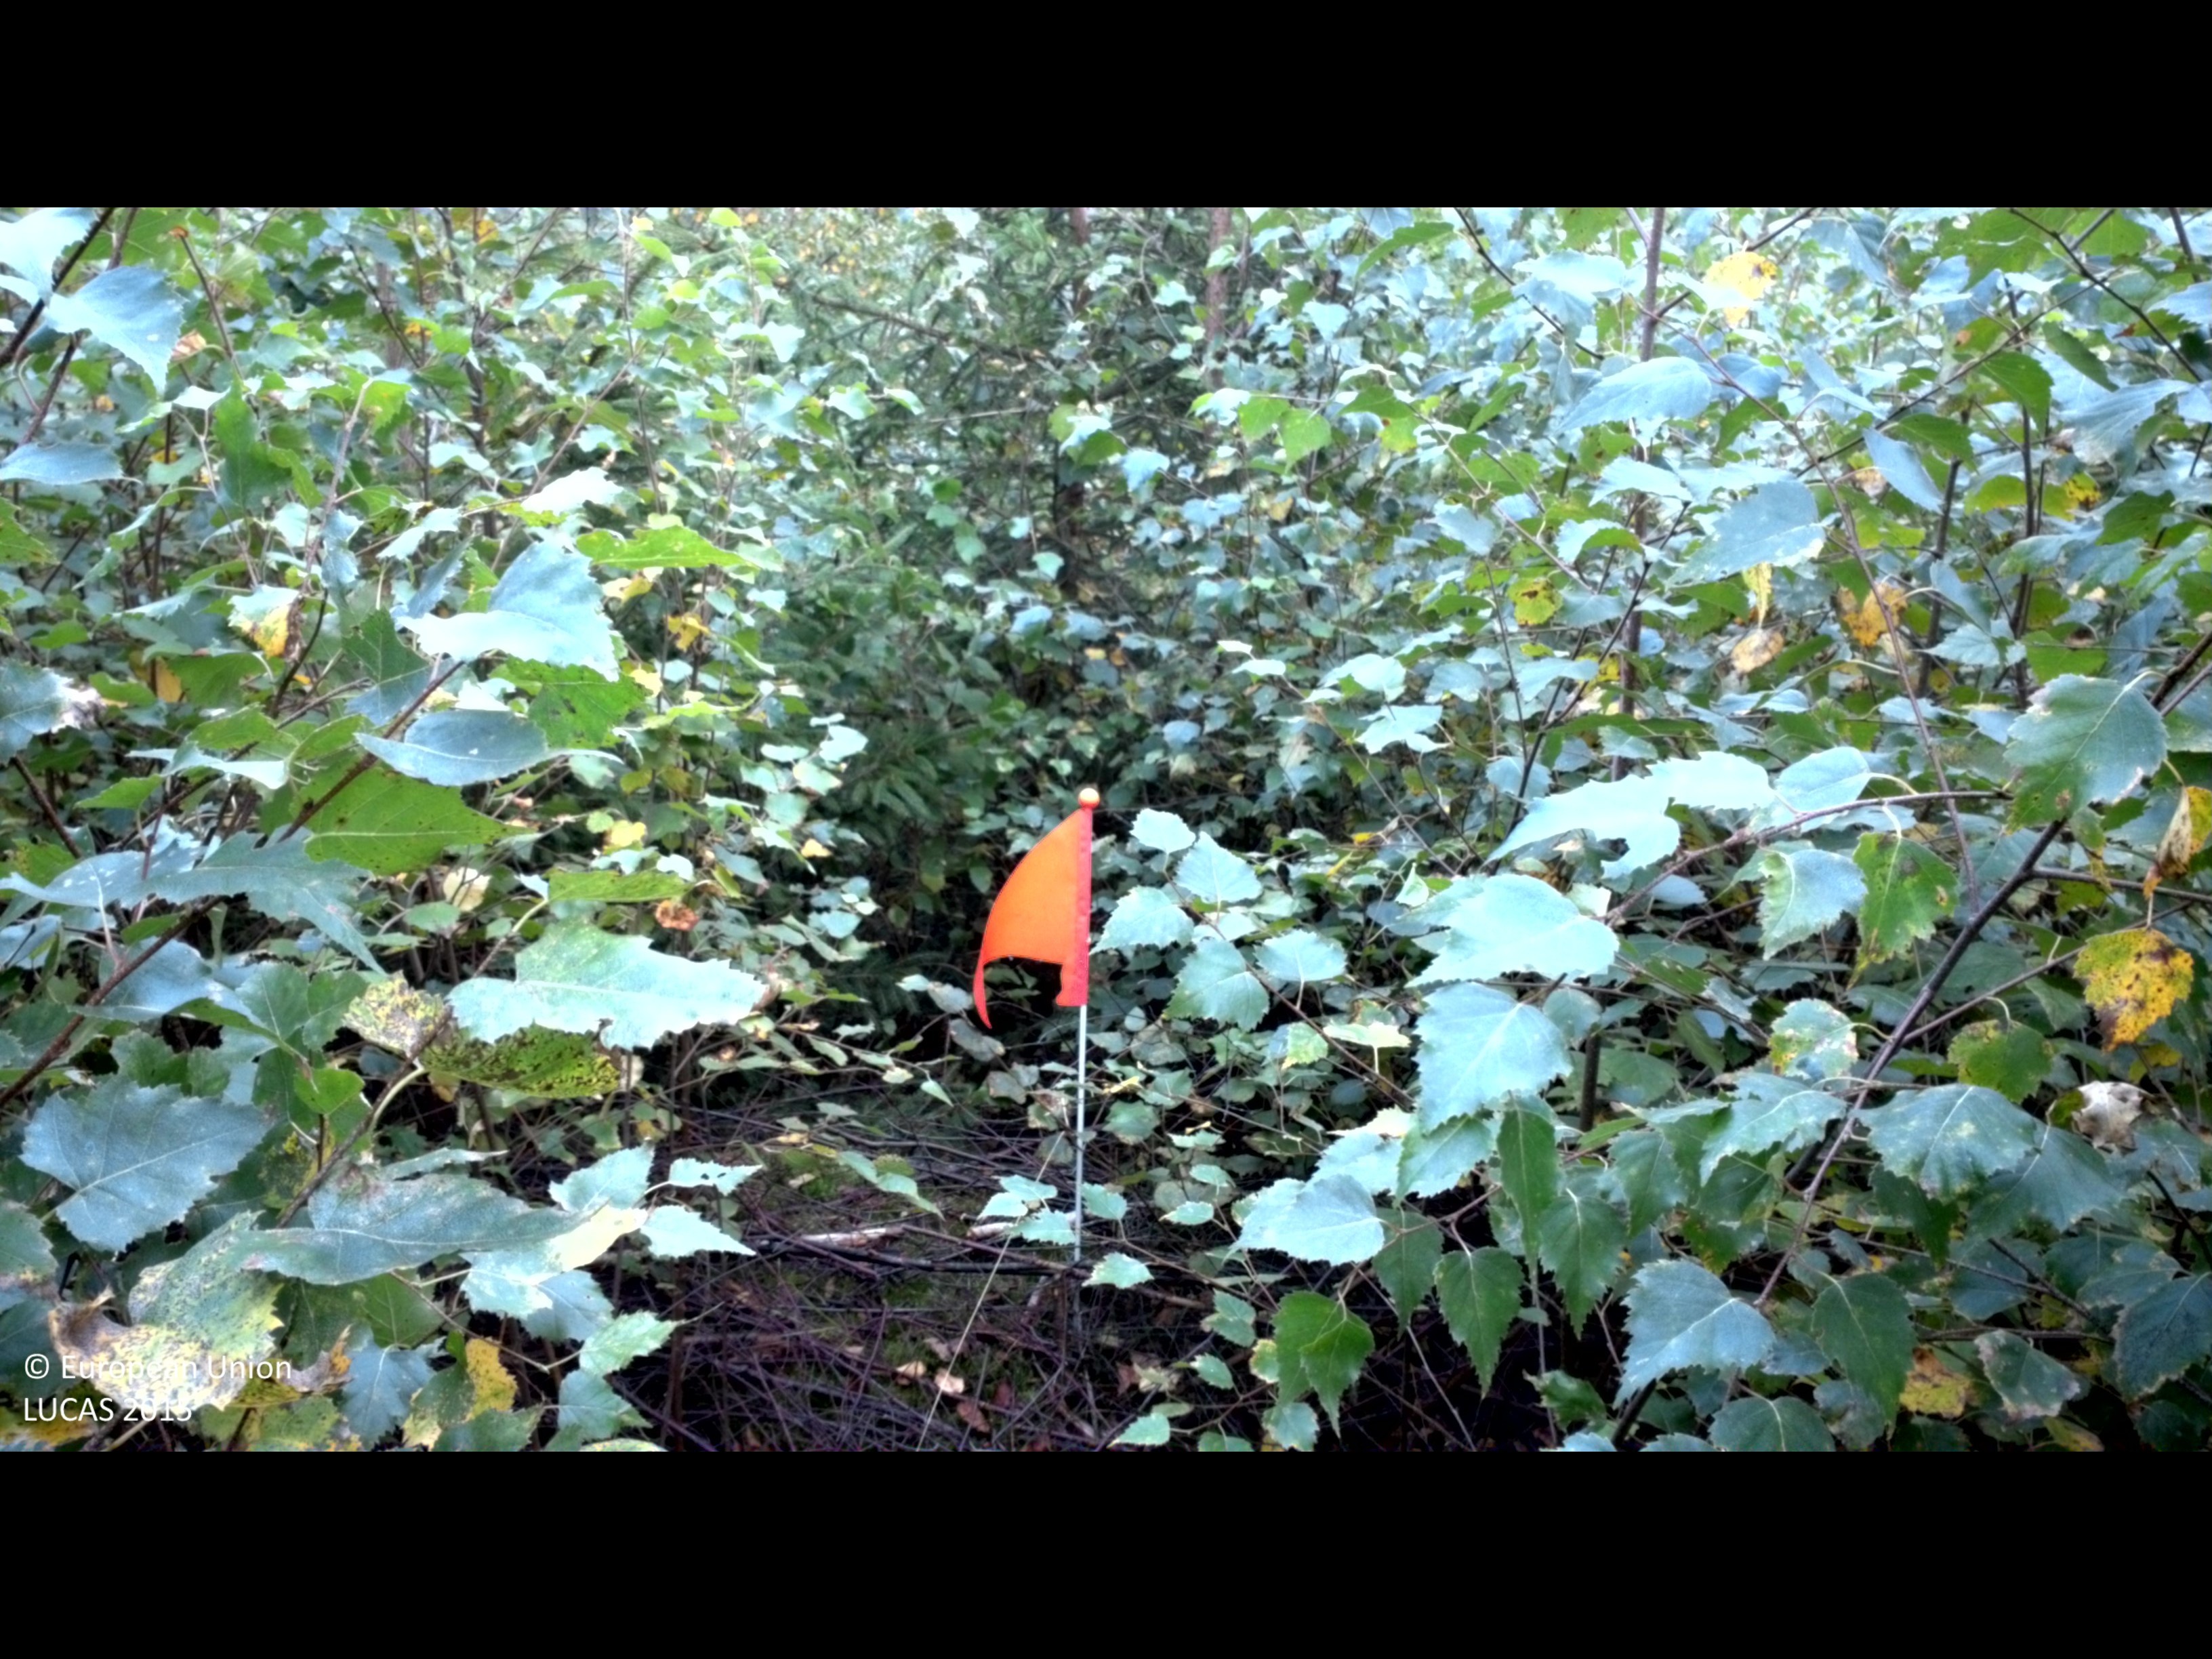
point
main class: Woodland
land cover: Spruce dominated mixed woodland
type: boreal forest
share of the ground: > 75 %
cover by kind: broadleaved forest trees 55 %, coniferous forest trees 35 %, shrubs 5 %, herbaceous plants 5 %
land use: Forestry
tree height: < 5 m
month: September
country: SE
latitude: 56.7616
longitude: 13.1211
